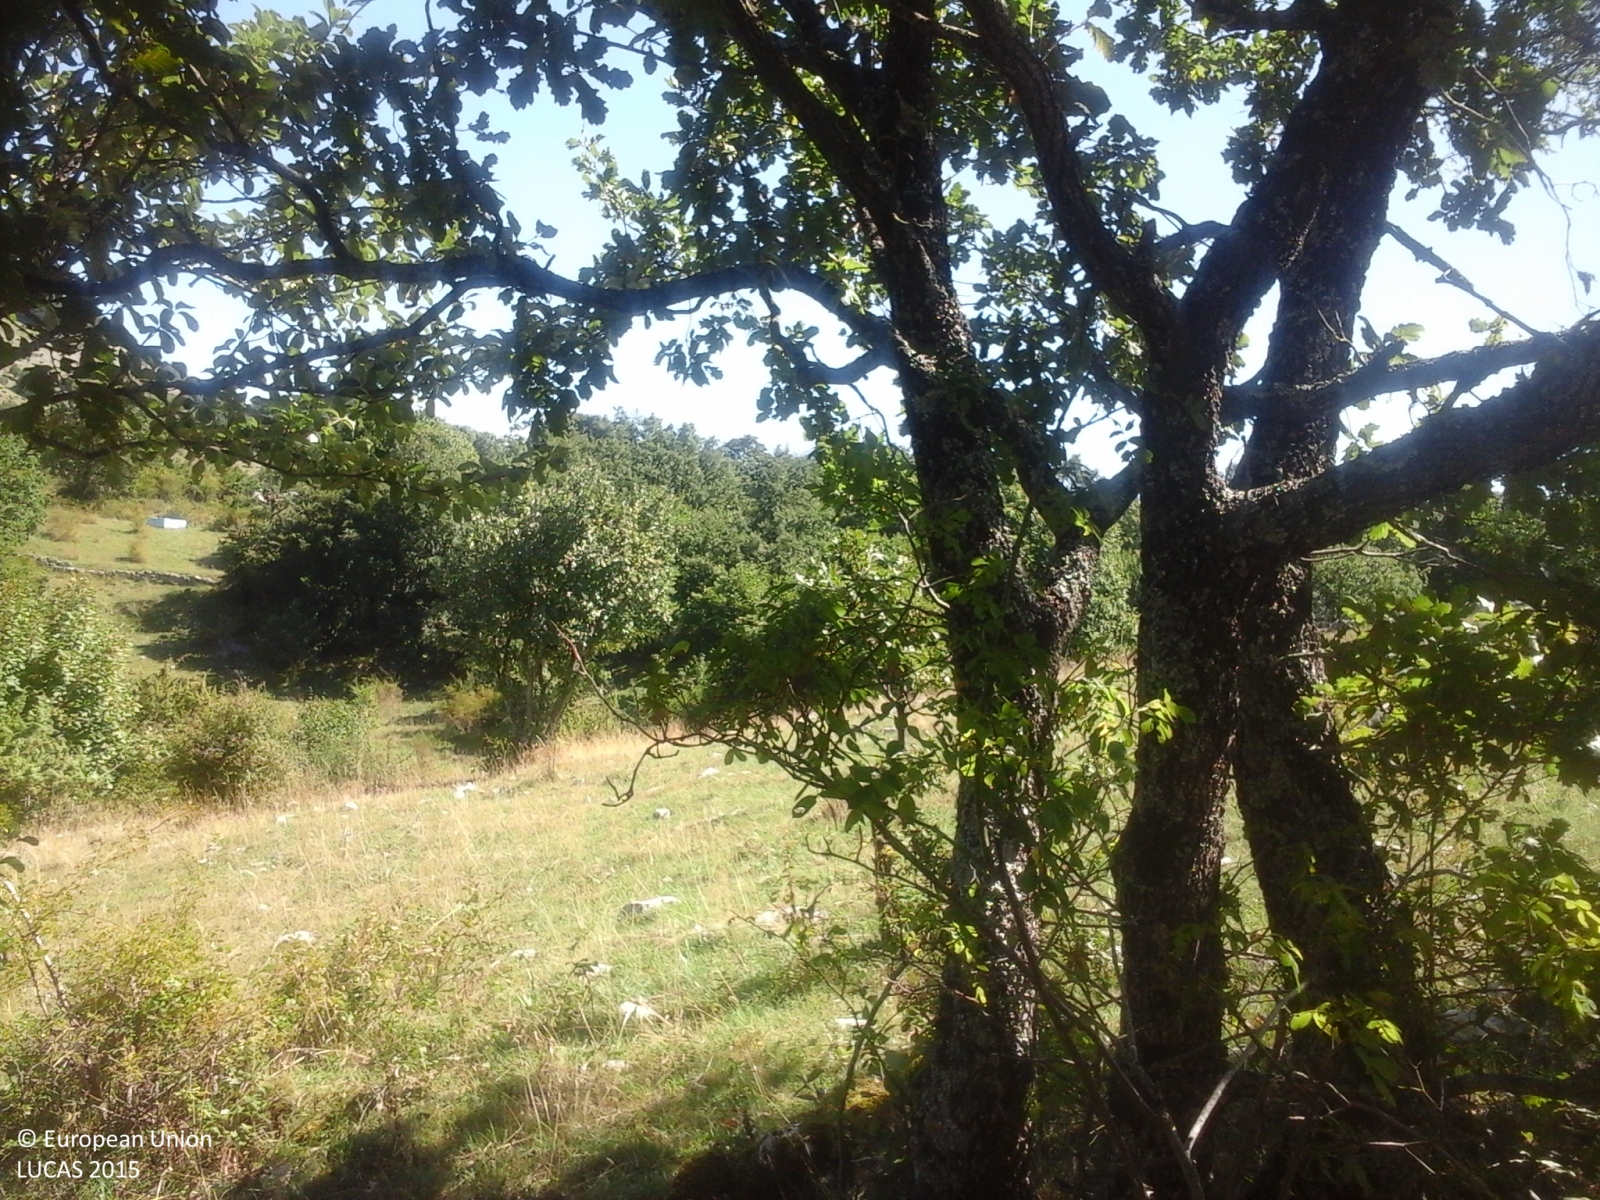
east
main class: Woodland
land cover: Broadleaved woodland
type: thermophilous deciduous forest
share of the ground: 50 - 75 %
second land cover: Grassland without tree/shrub cover
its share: > 75 %
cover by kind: broadleaved forest trees 100 %
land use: Forestry
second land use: Agriculture (excluding fallow land and kitchen gardens)
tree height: < 5 m
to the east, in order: Broadleaved woodland; Grassland without tree/shrub cover; Dry stone walls; Fences; Broadleaved woodland; Dry stone walls; Broadleaved woodland; Dry stone walls; Broadleaved woodland
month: August
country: IT
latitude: 41.8989
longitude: 13.1828
